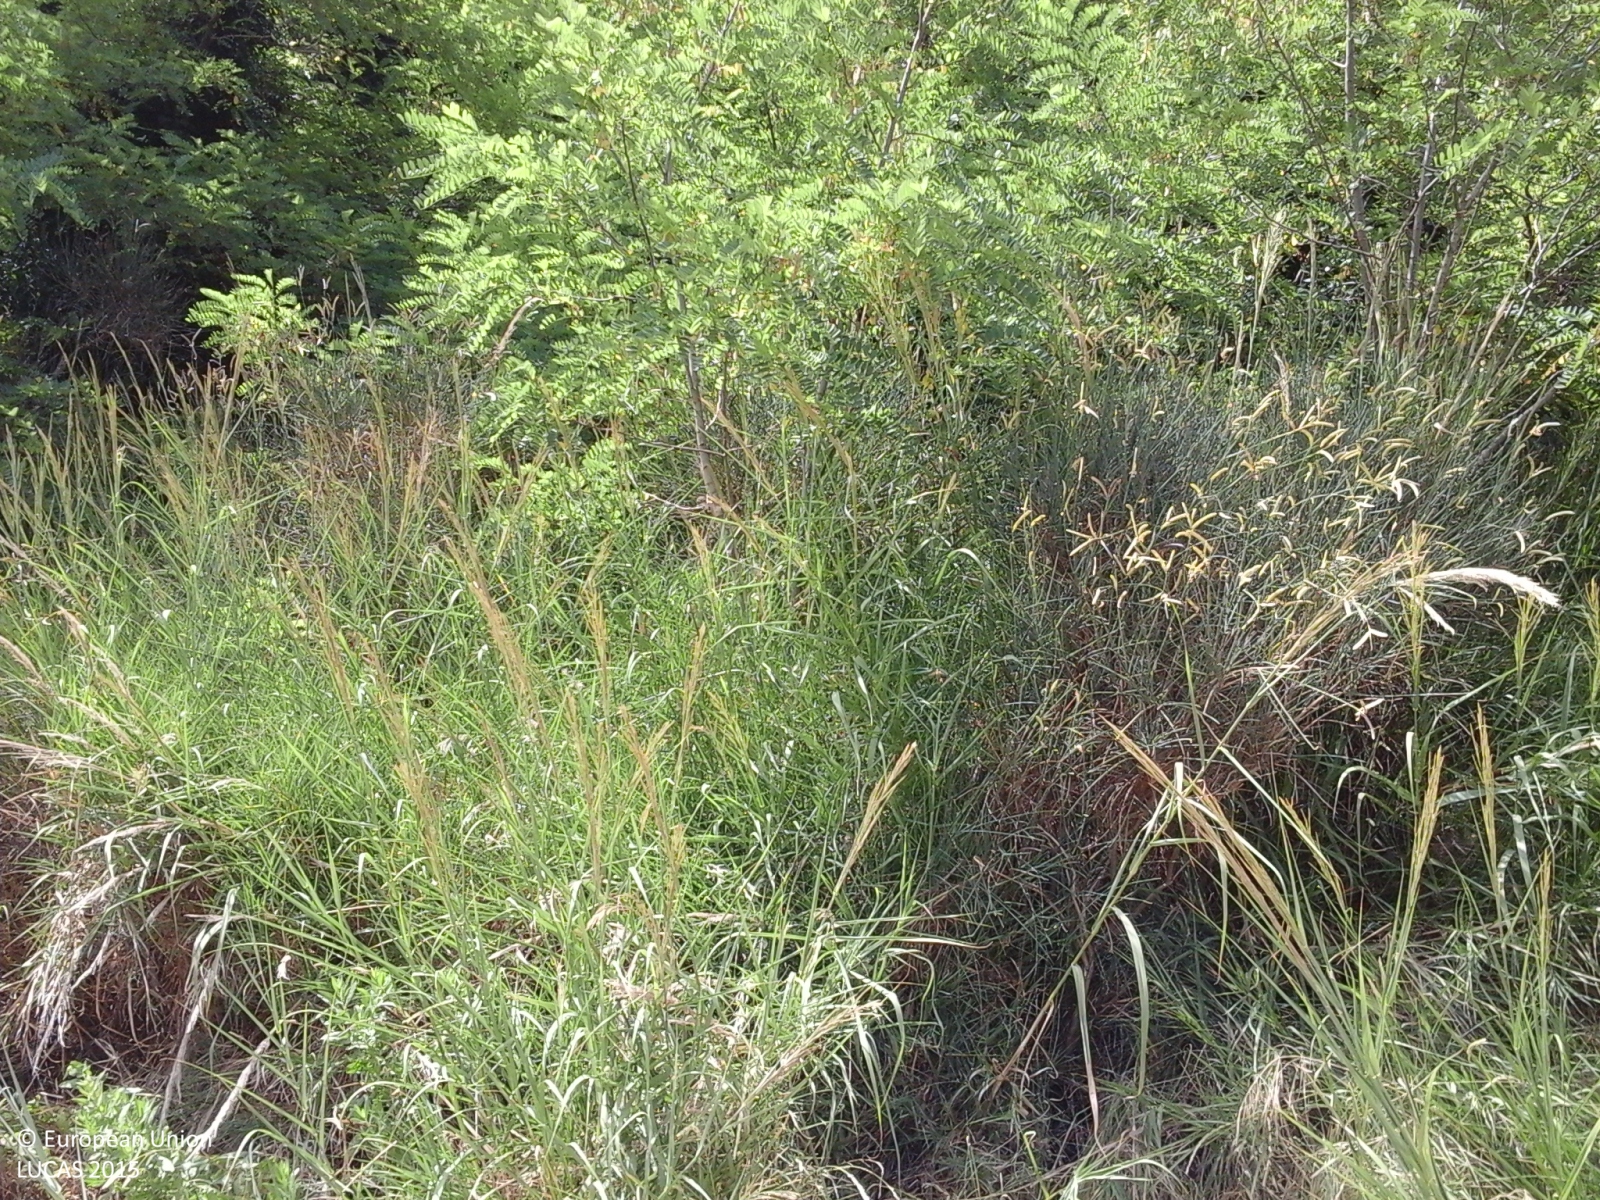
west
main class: Woodland
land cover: Broadleaved woodland
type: thermophilous deciduous forest
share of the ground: > 75 %
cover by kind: broadleaved forest trees 100 %
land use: Semi-natural and natural areas not in use
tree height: > 5 m
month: July
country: IT
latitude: 43.9030
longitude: 12.5960
